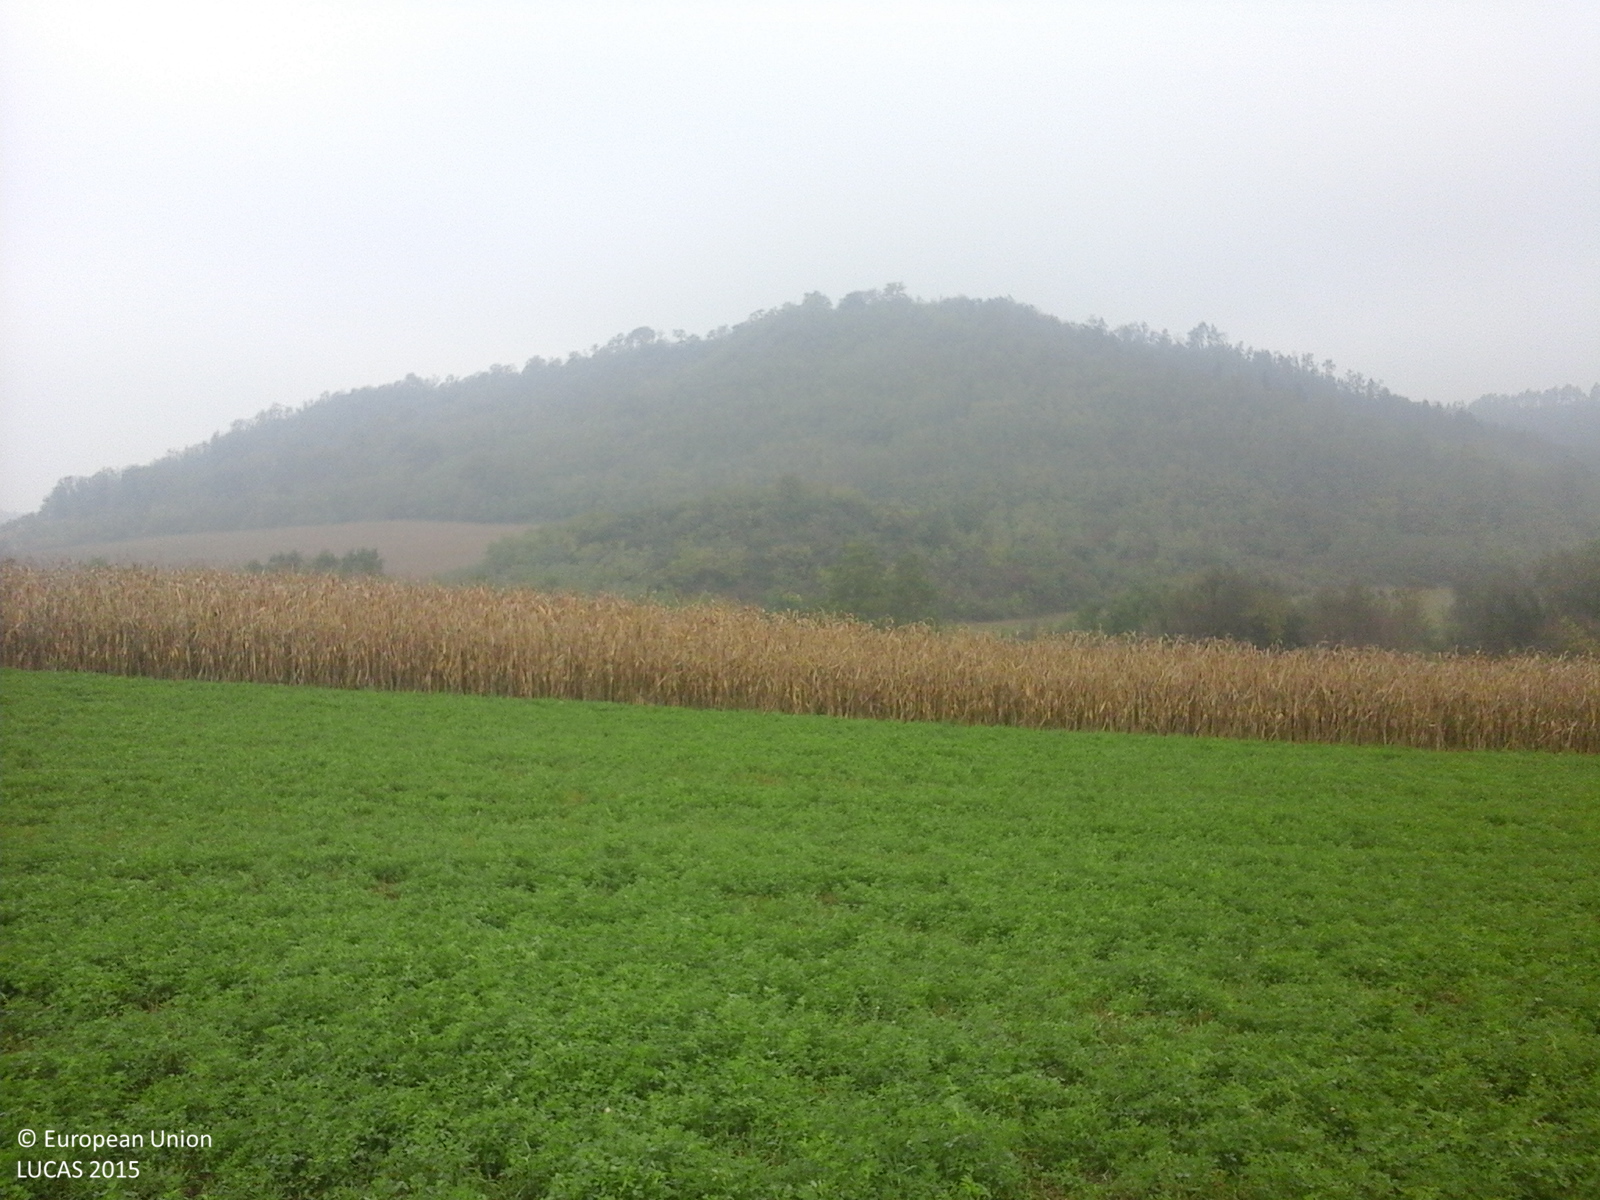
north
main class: Cropland
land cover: Lucerne
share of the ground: > 75 %
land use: Agriculture (excluding fallow land and kitchen gardens)
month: October
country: RO
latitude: 46.5279
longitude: 24.3595
